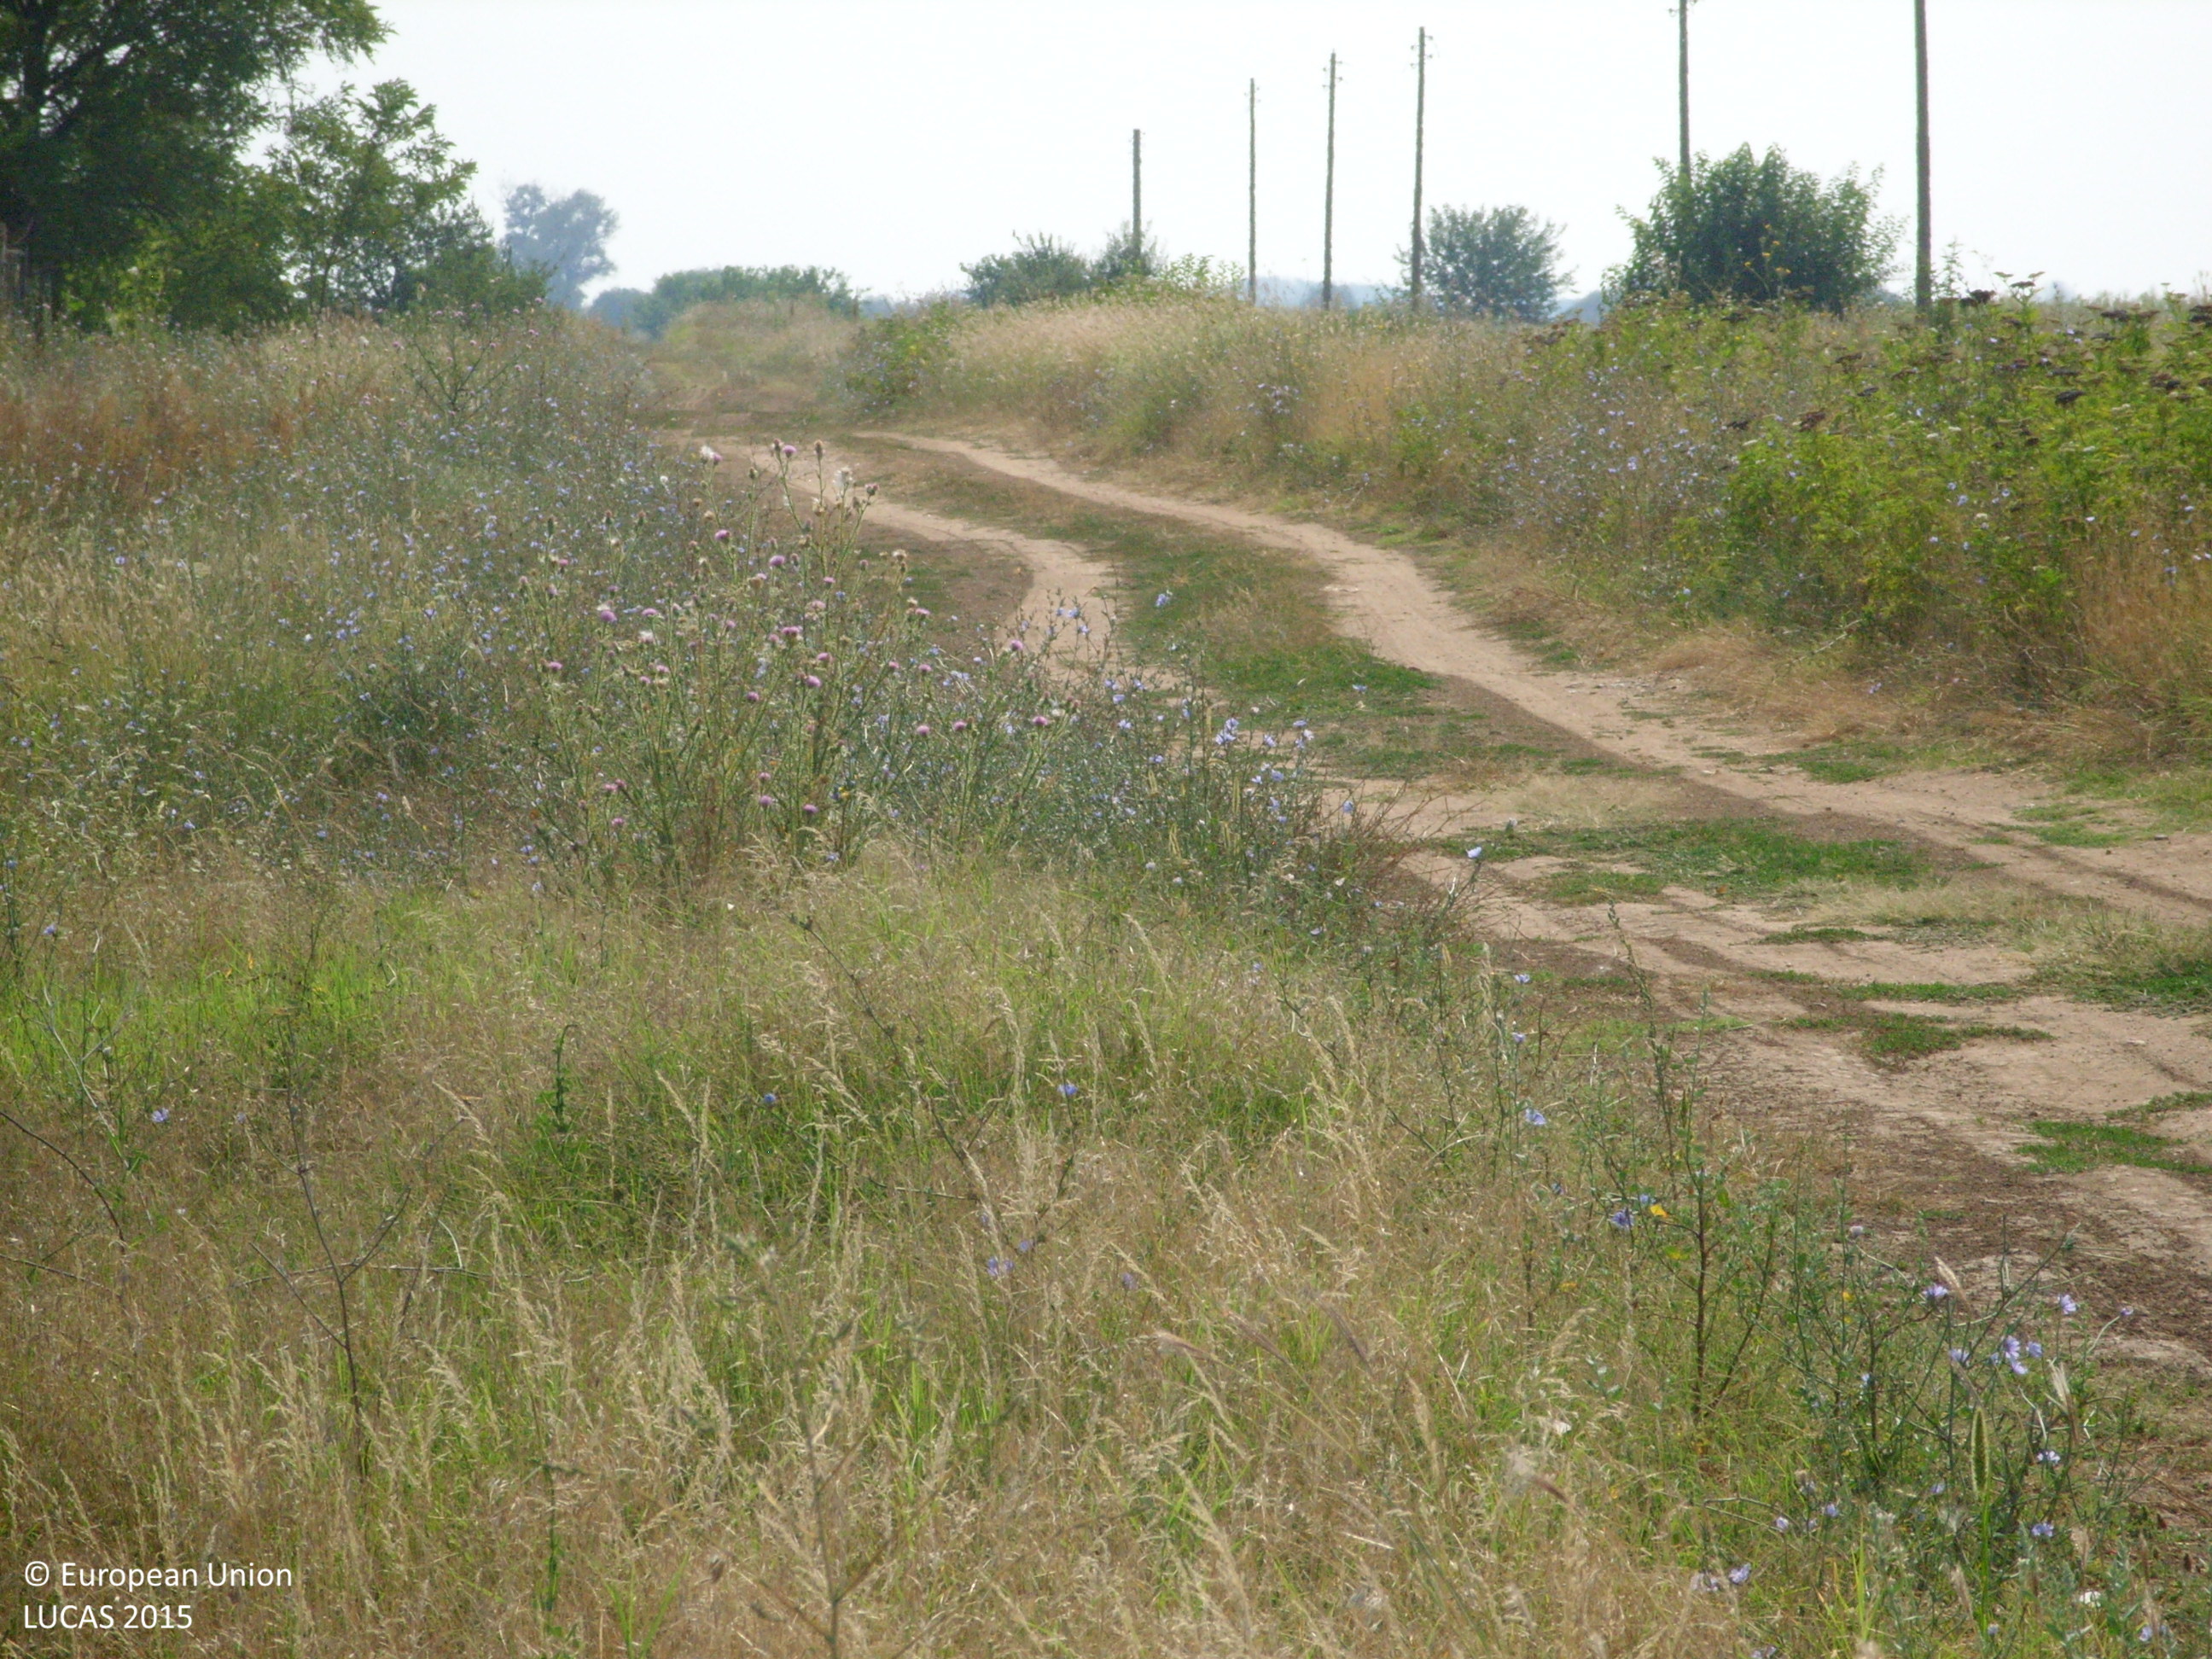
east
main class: Cropland
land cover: Sunflower
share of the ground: > 75 %
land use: Agriculture (excluding fallow land and kitchen gardens)
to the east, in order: Sunflower; Grass margins; Ditches and canals; Grass margins; Sunflower
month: July
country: BG
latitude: 42.2978
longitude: 24.6431
